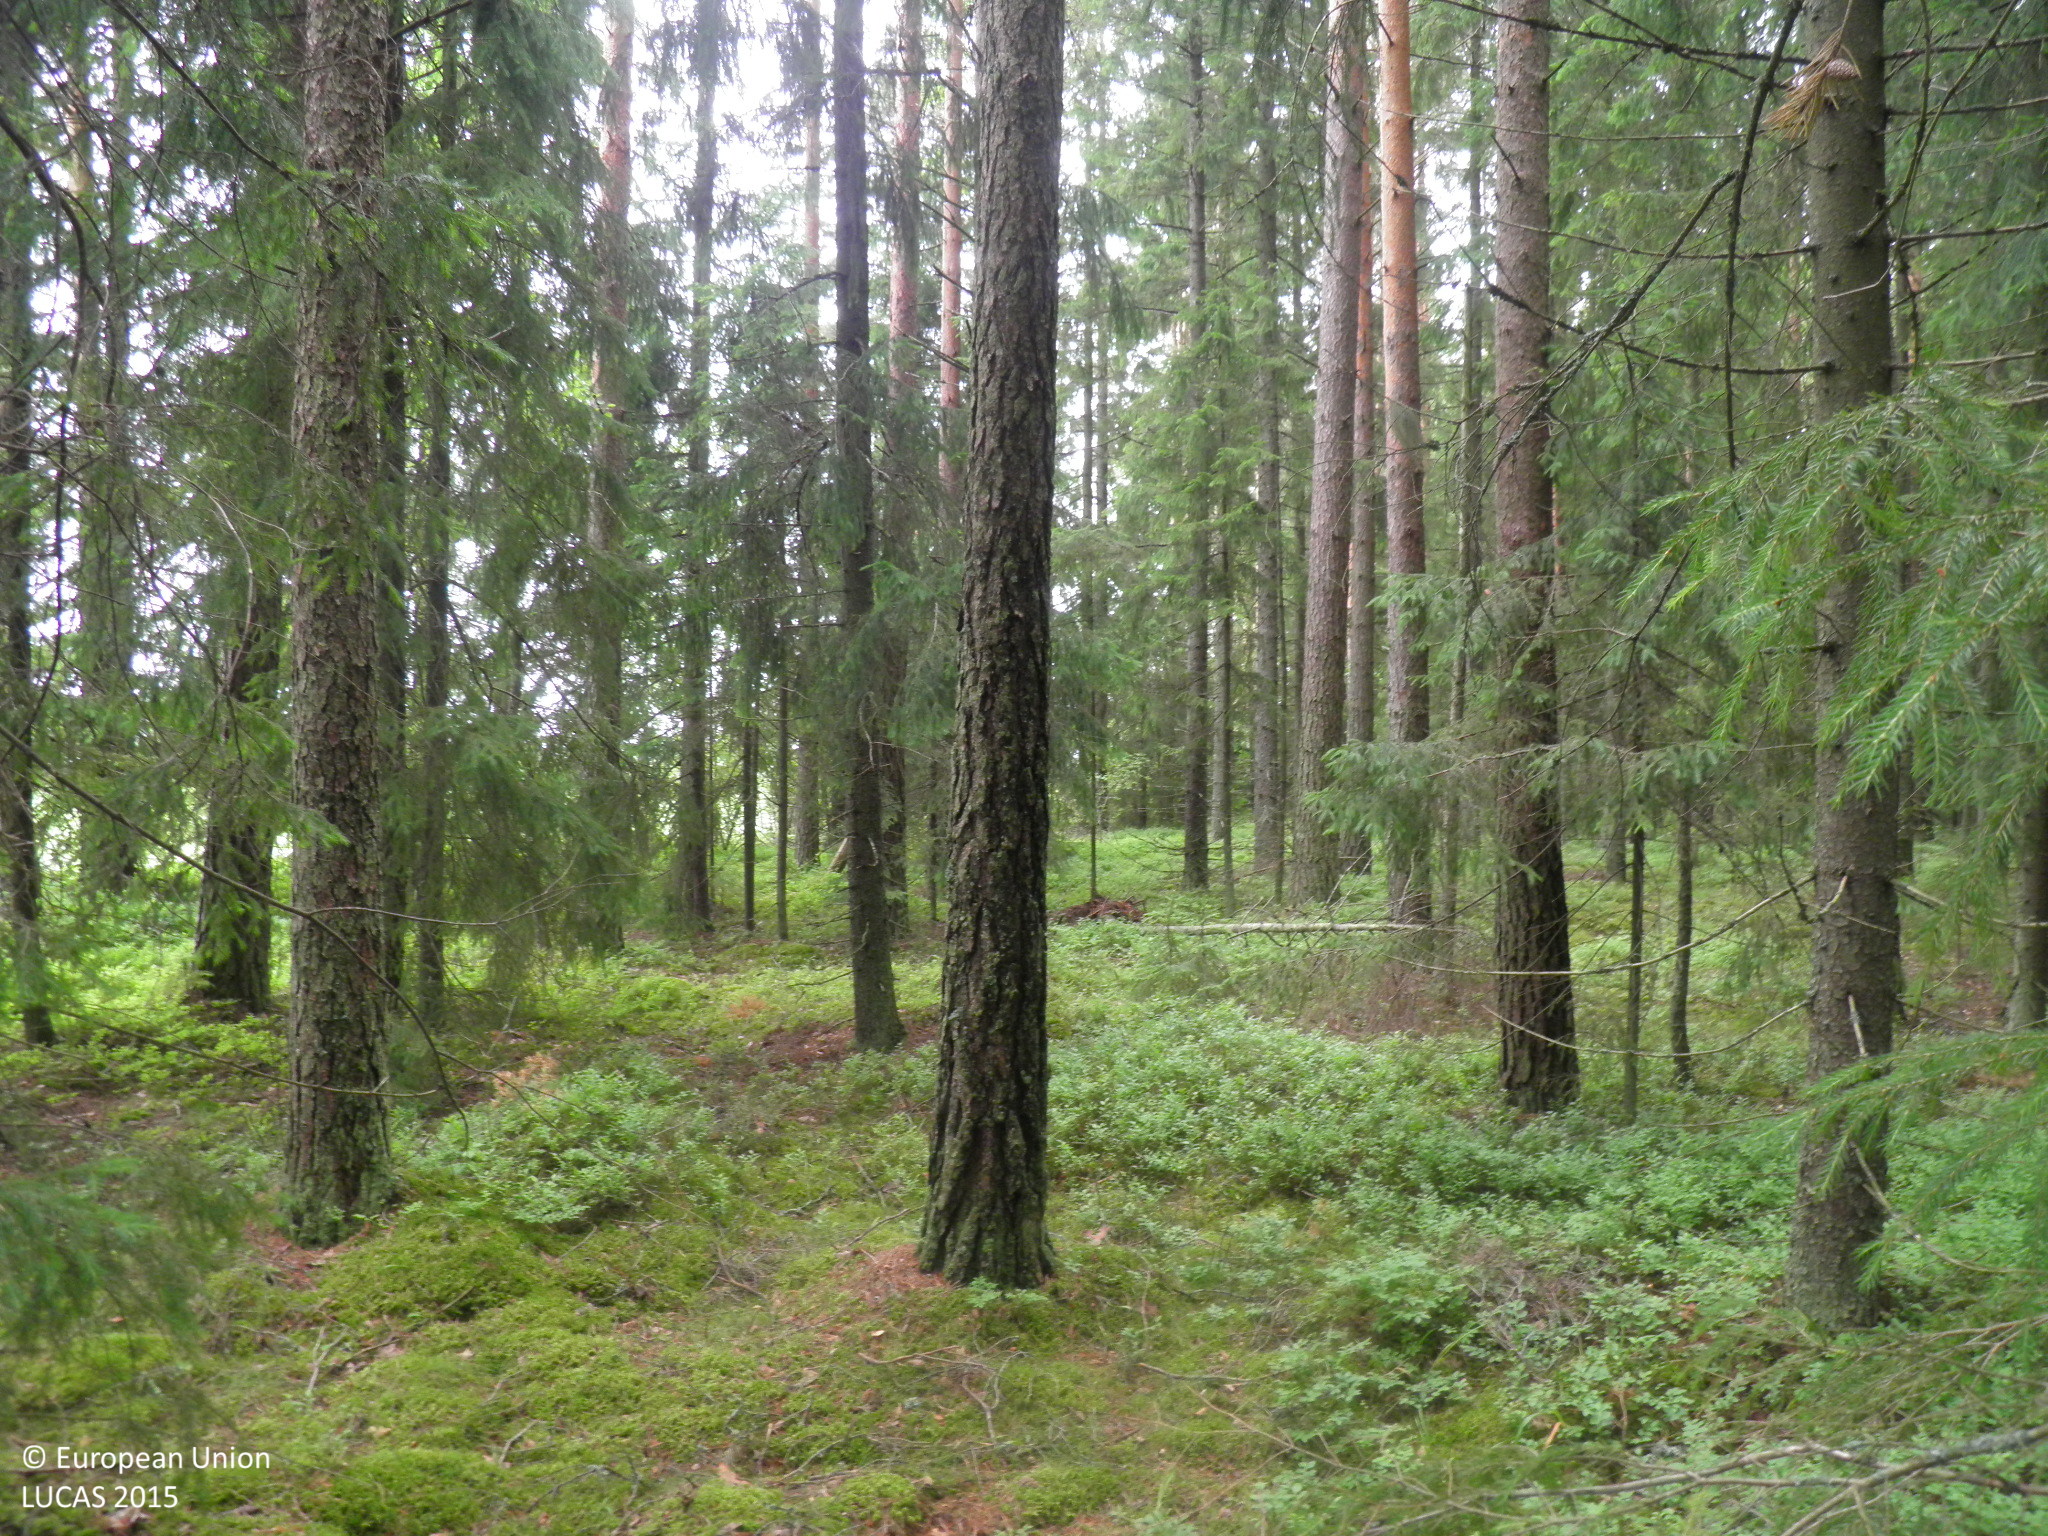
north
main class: Woodland
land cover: Spruce dominated coniferous woodland
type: boreal forest
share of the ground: > 75 %
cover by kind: coniferous forest trees 60 %, broadleaved forest trees 15 %, shrubs 15 %, lichens and mosses 10 %
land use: Forestry
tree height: > 5 m
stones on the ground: < 10 %
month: July
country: FI
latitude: 60.7054
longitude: 22.8442
